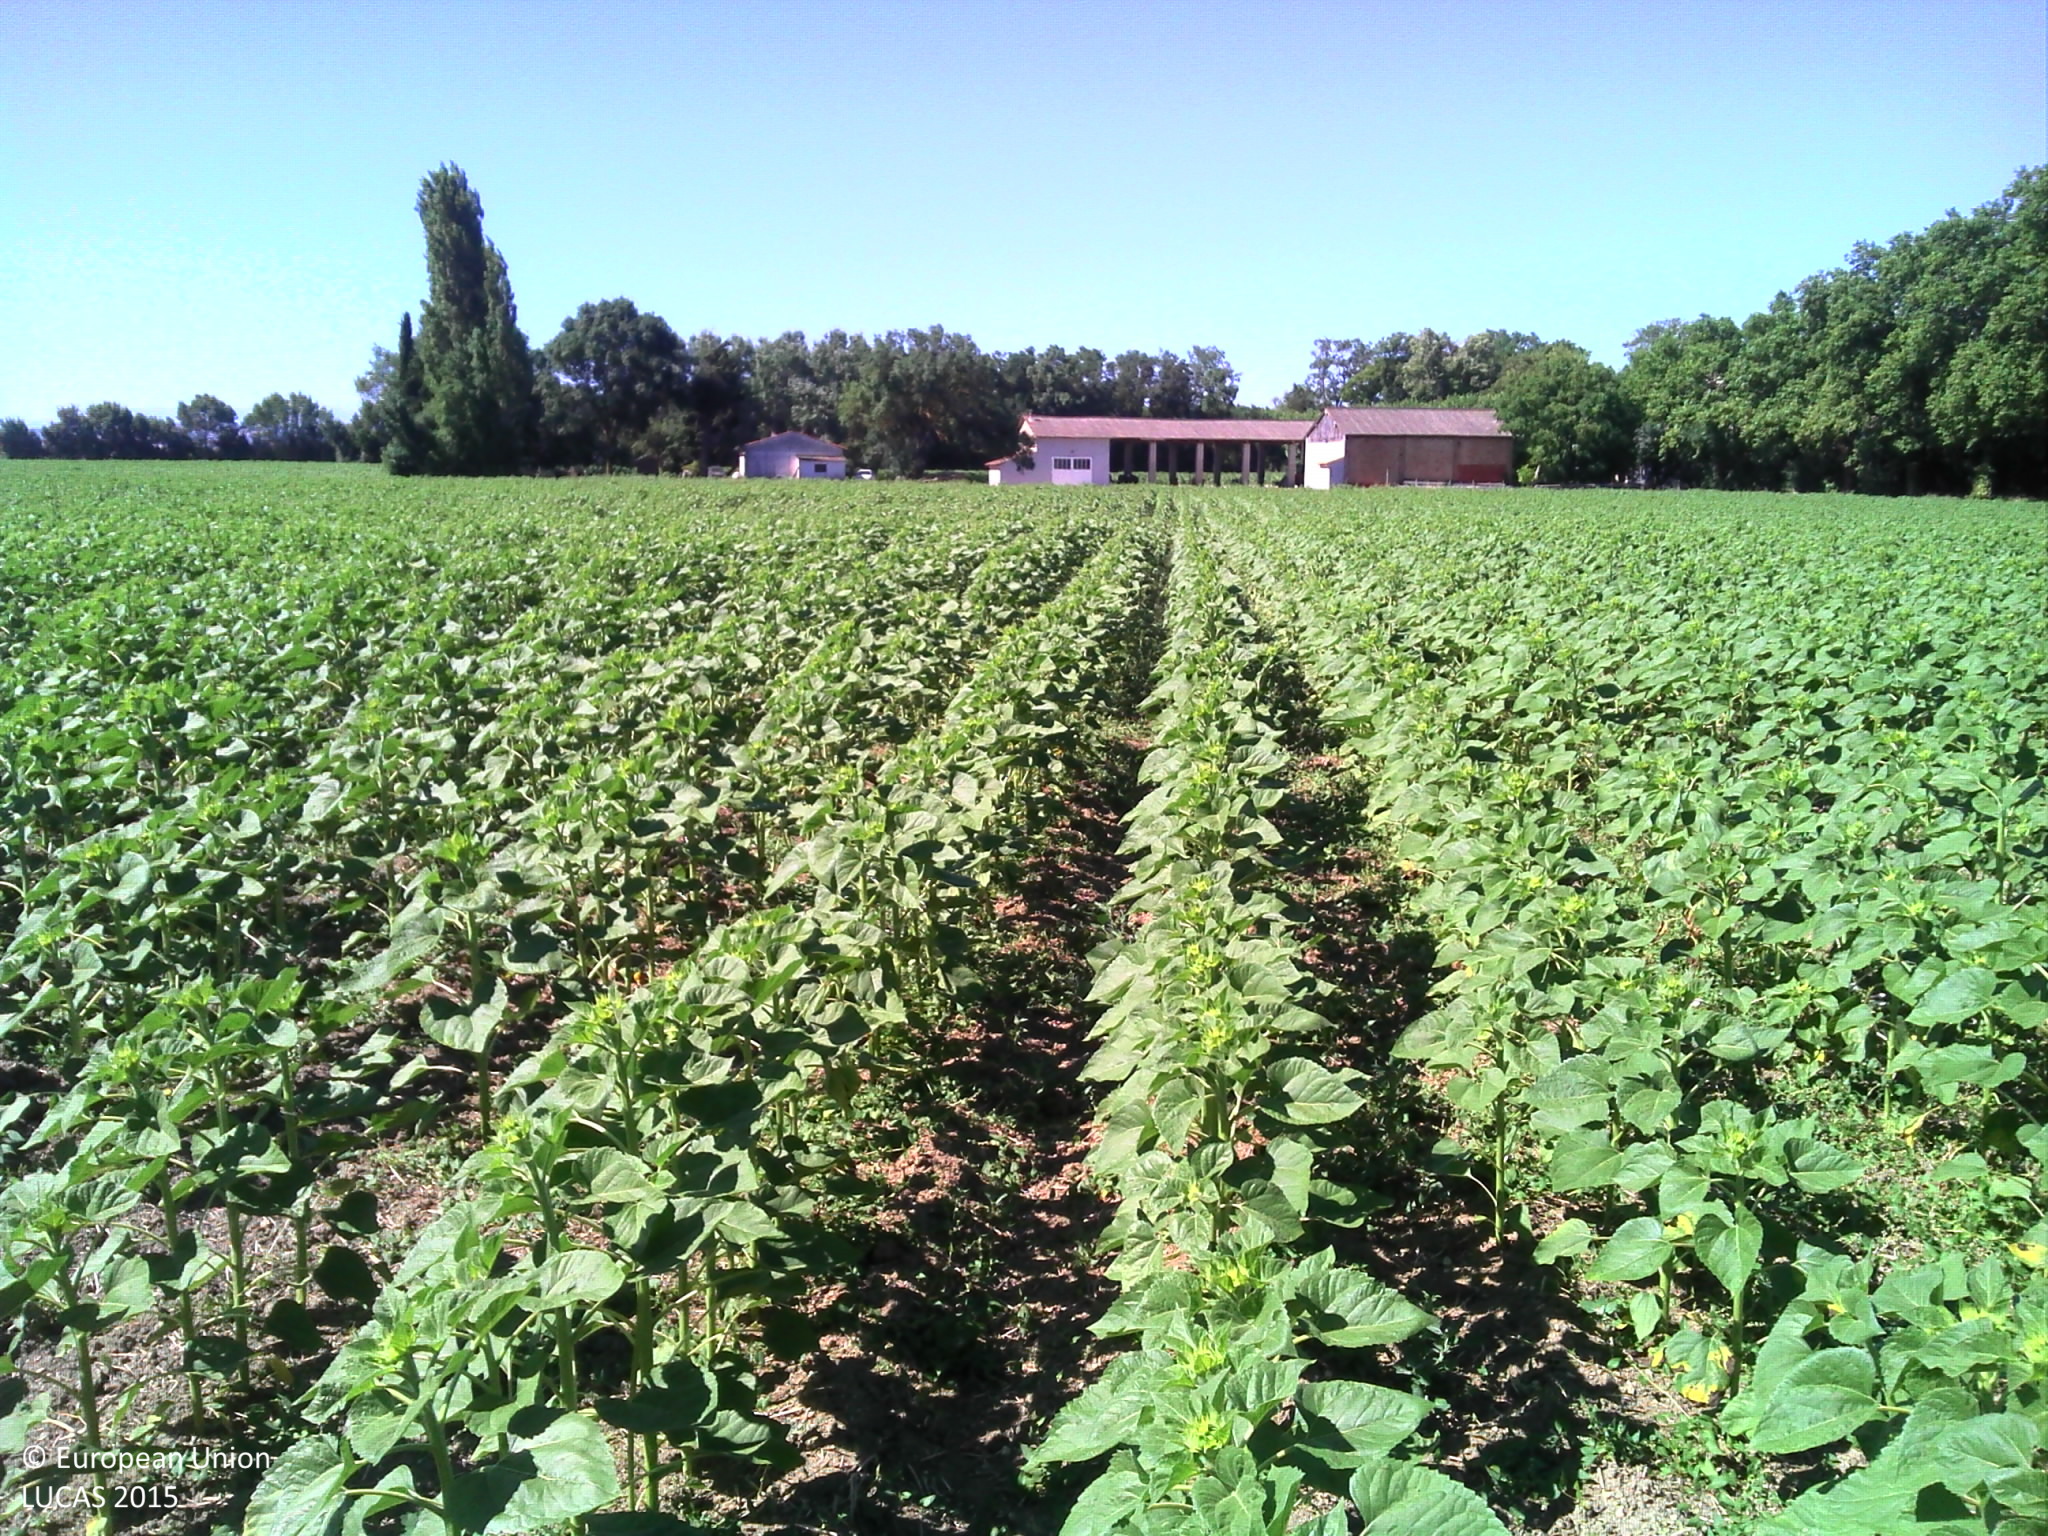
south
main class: Cropland
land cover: Sunflower
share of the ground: 50 - 75 %
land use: Agriculture (excluding fallow land and kitchen gardens)
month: June
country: FR
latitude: 43.2828
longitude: 2.0335
